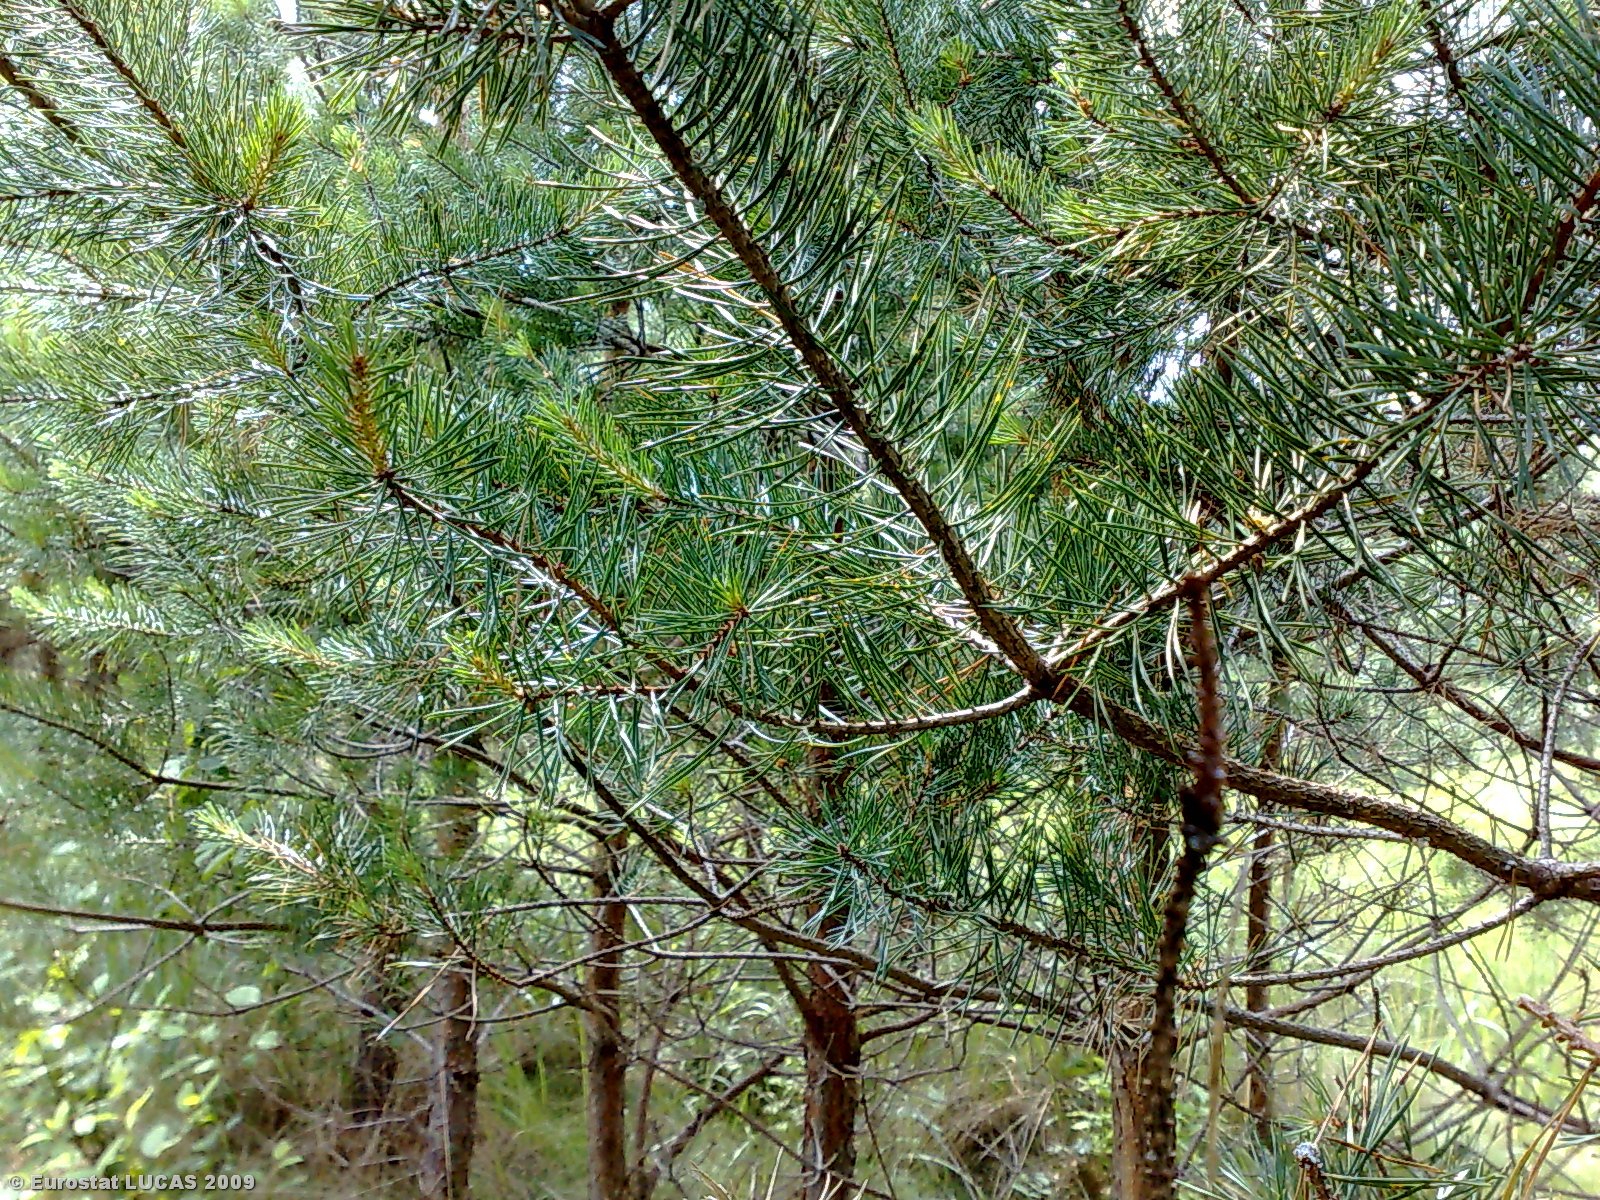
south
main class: Woodland
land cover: Coniferous woodland
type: hemiboreal forest and nemoral coniferous forest and mixed broadleaved-coniferous forest
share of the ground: > 75 %
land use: Forestry
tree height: > 5 m
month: July
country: LT
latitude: 55.5618
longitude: 22.7979
